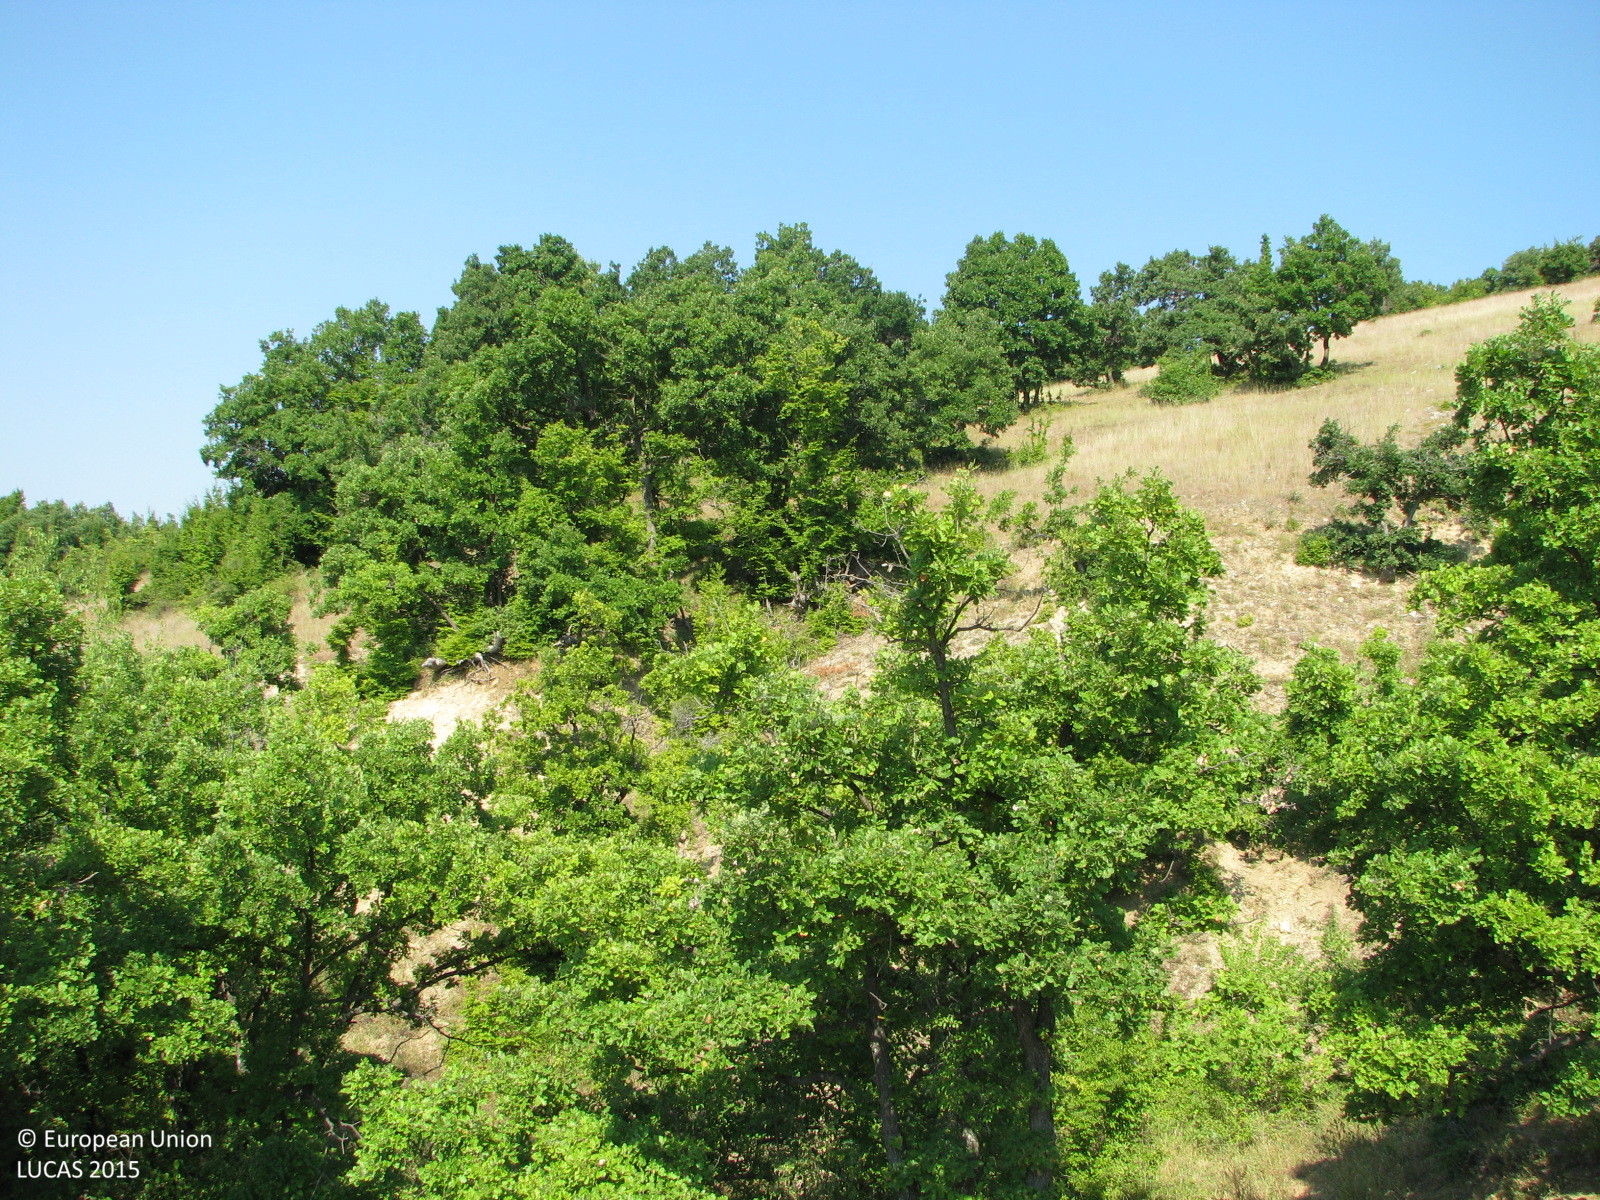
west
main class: Grassland
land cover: Grassland with sparse tree/shrub cover
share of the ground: > 75 %
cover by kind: herbaceous plants 90 %, broadleaved forest trees 5 %, shrubs 5 %
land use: Agriculture (excluding fallow land and kitchen gardens)
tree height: > 5 m
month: July
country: BG
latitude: 42.6741
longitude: 26.1321
